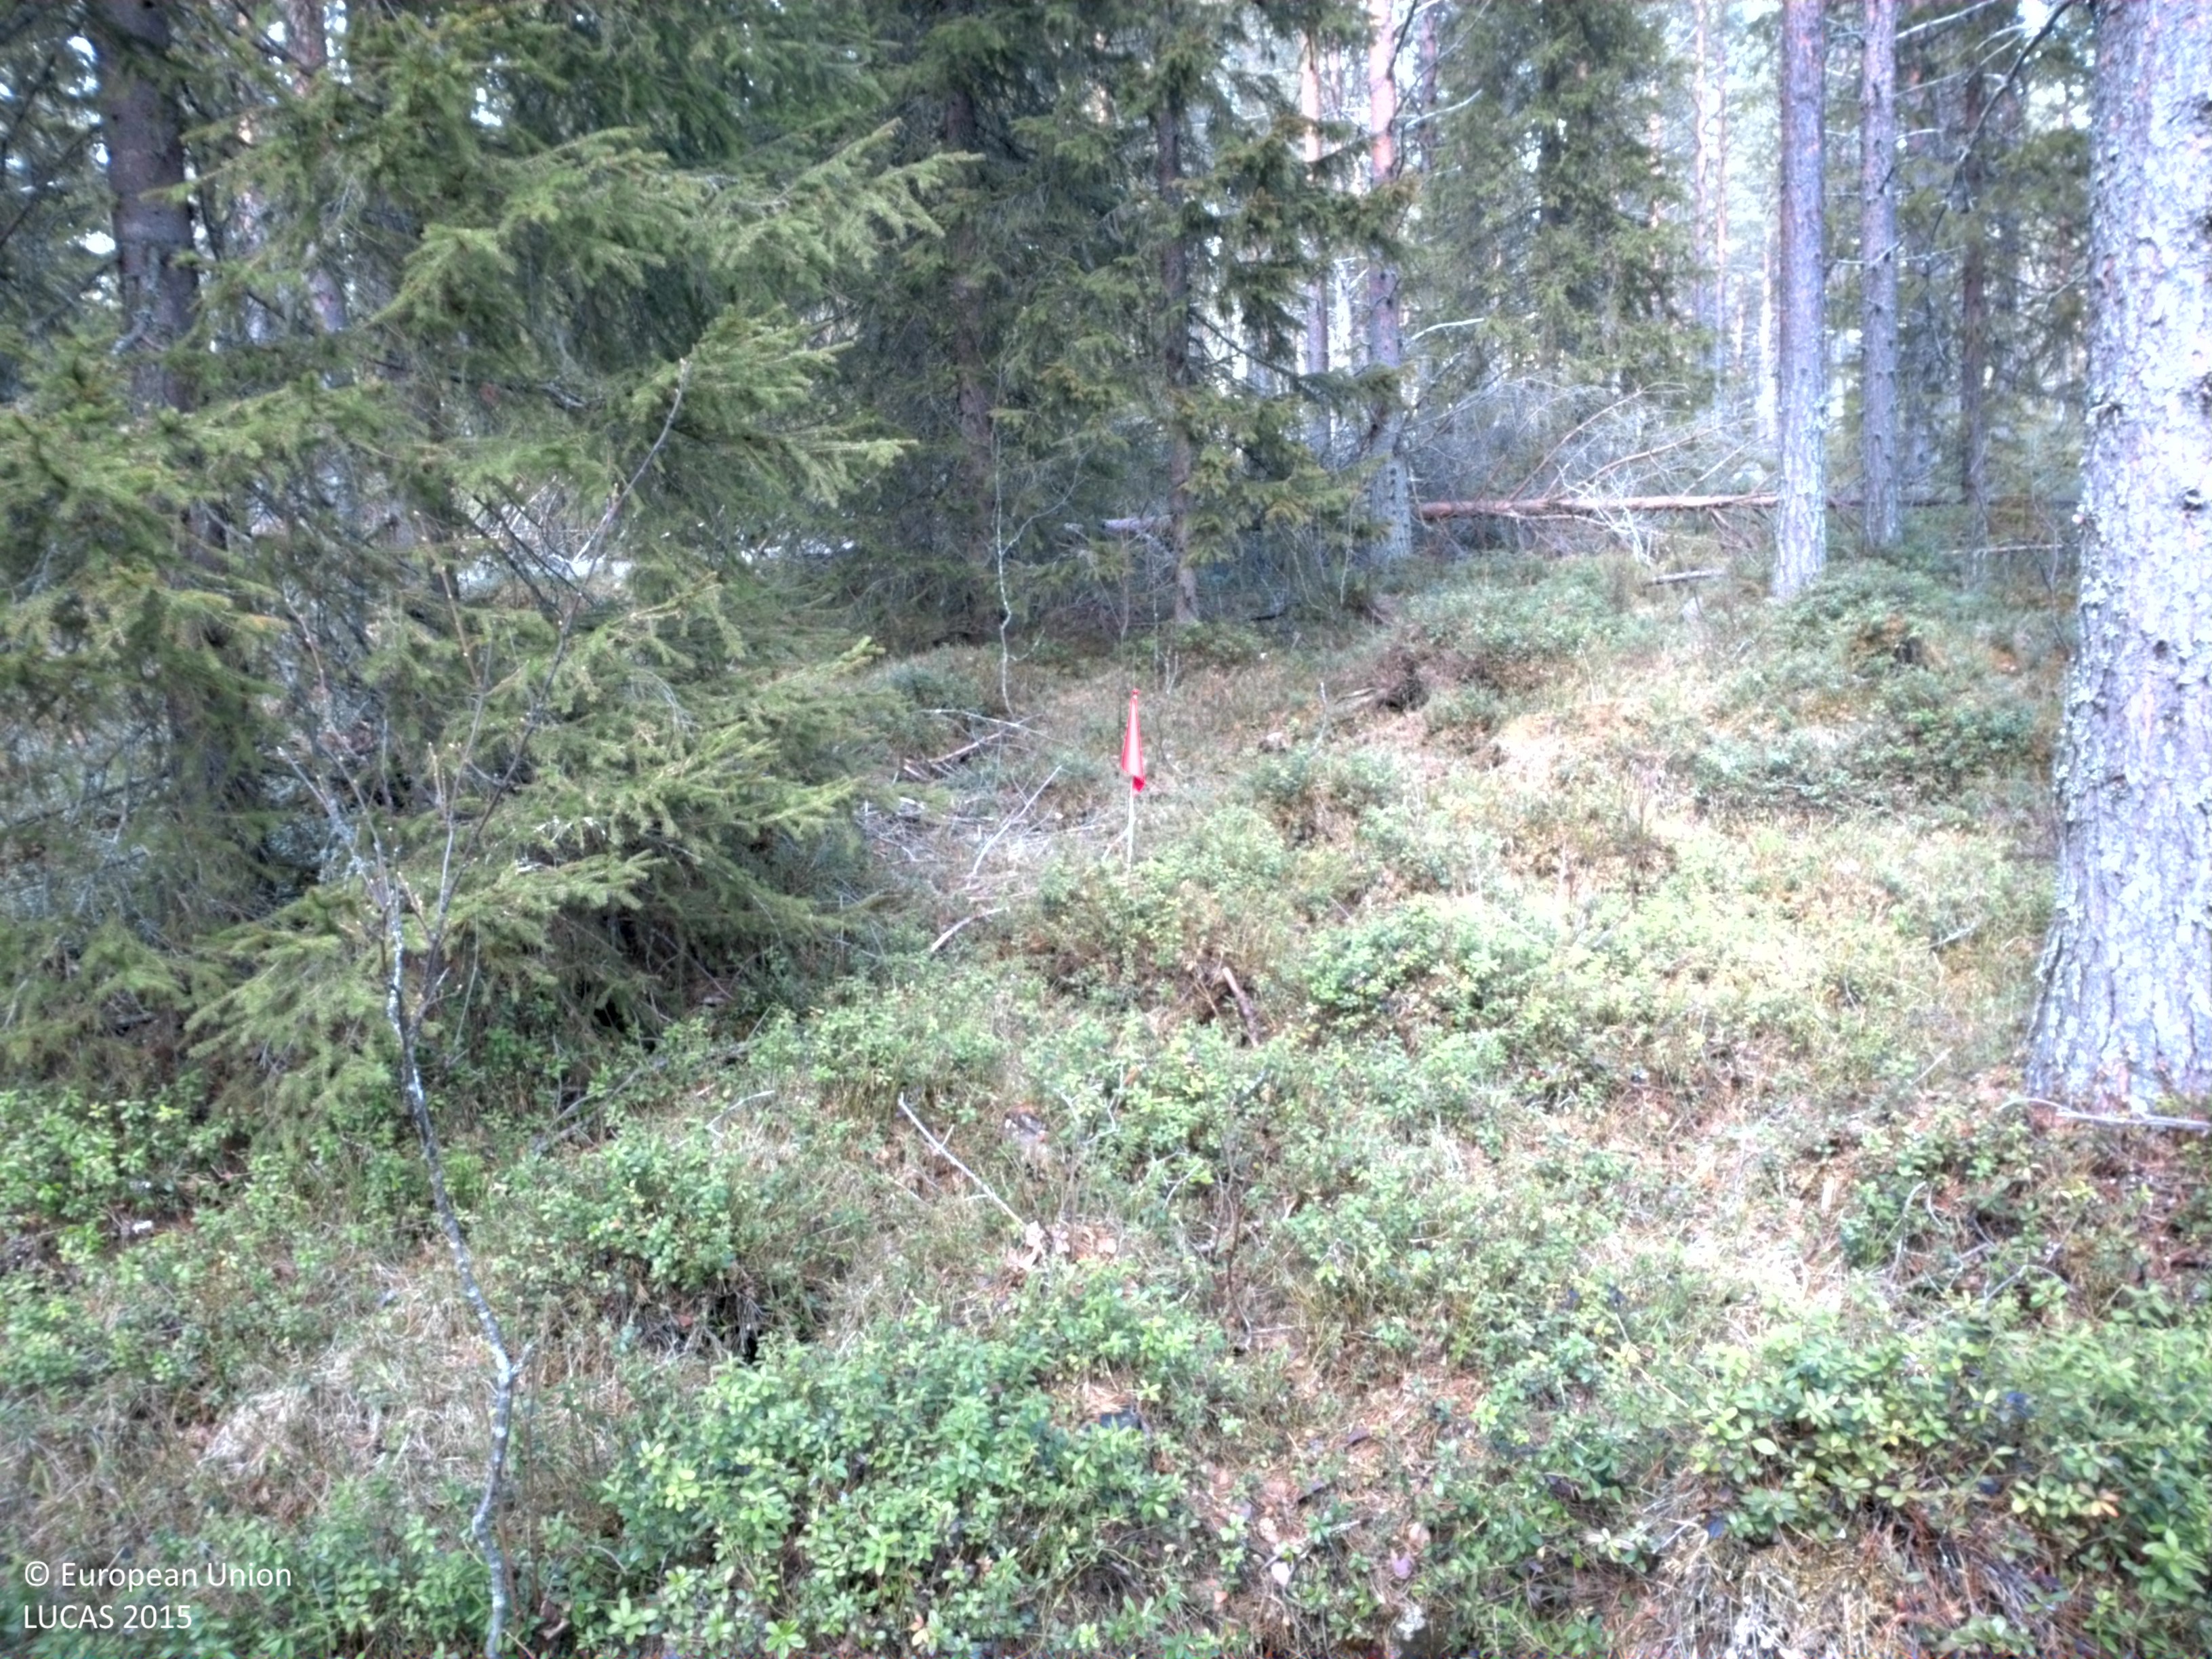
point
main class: Woodland
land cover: Pine dominated coniferous woodland
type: boreal forest
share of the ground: 50 - 75 %
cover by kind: coniferous forest trees 60 %, herbaceous plants 30 %, broadleaved forest trees 5 %, lichens and mosses 5 %
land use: Forestry
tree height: > 5 m
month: May
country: SE
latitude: 64.2631
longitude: 17.7503
